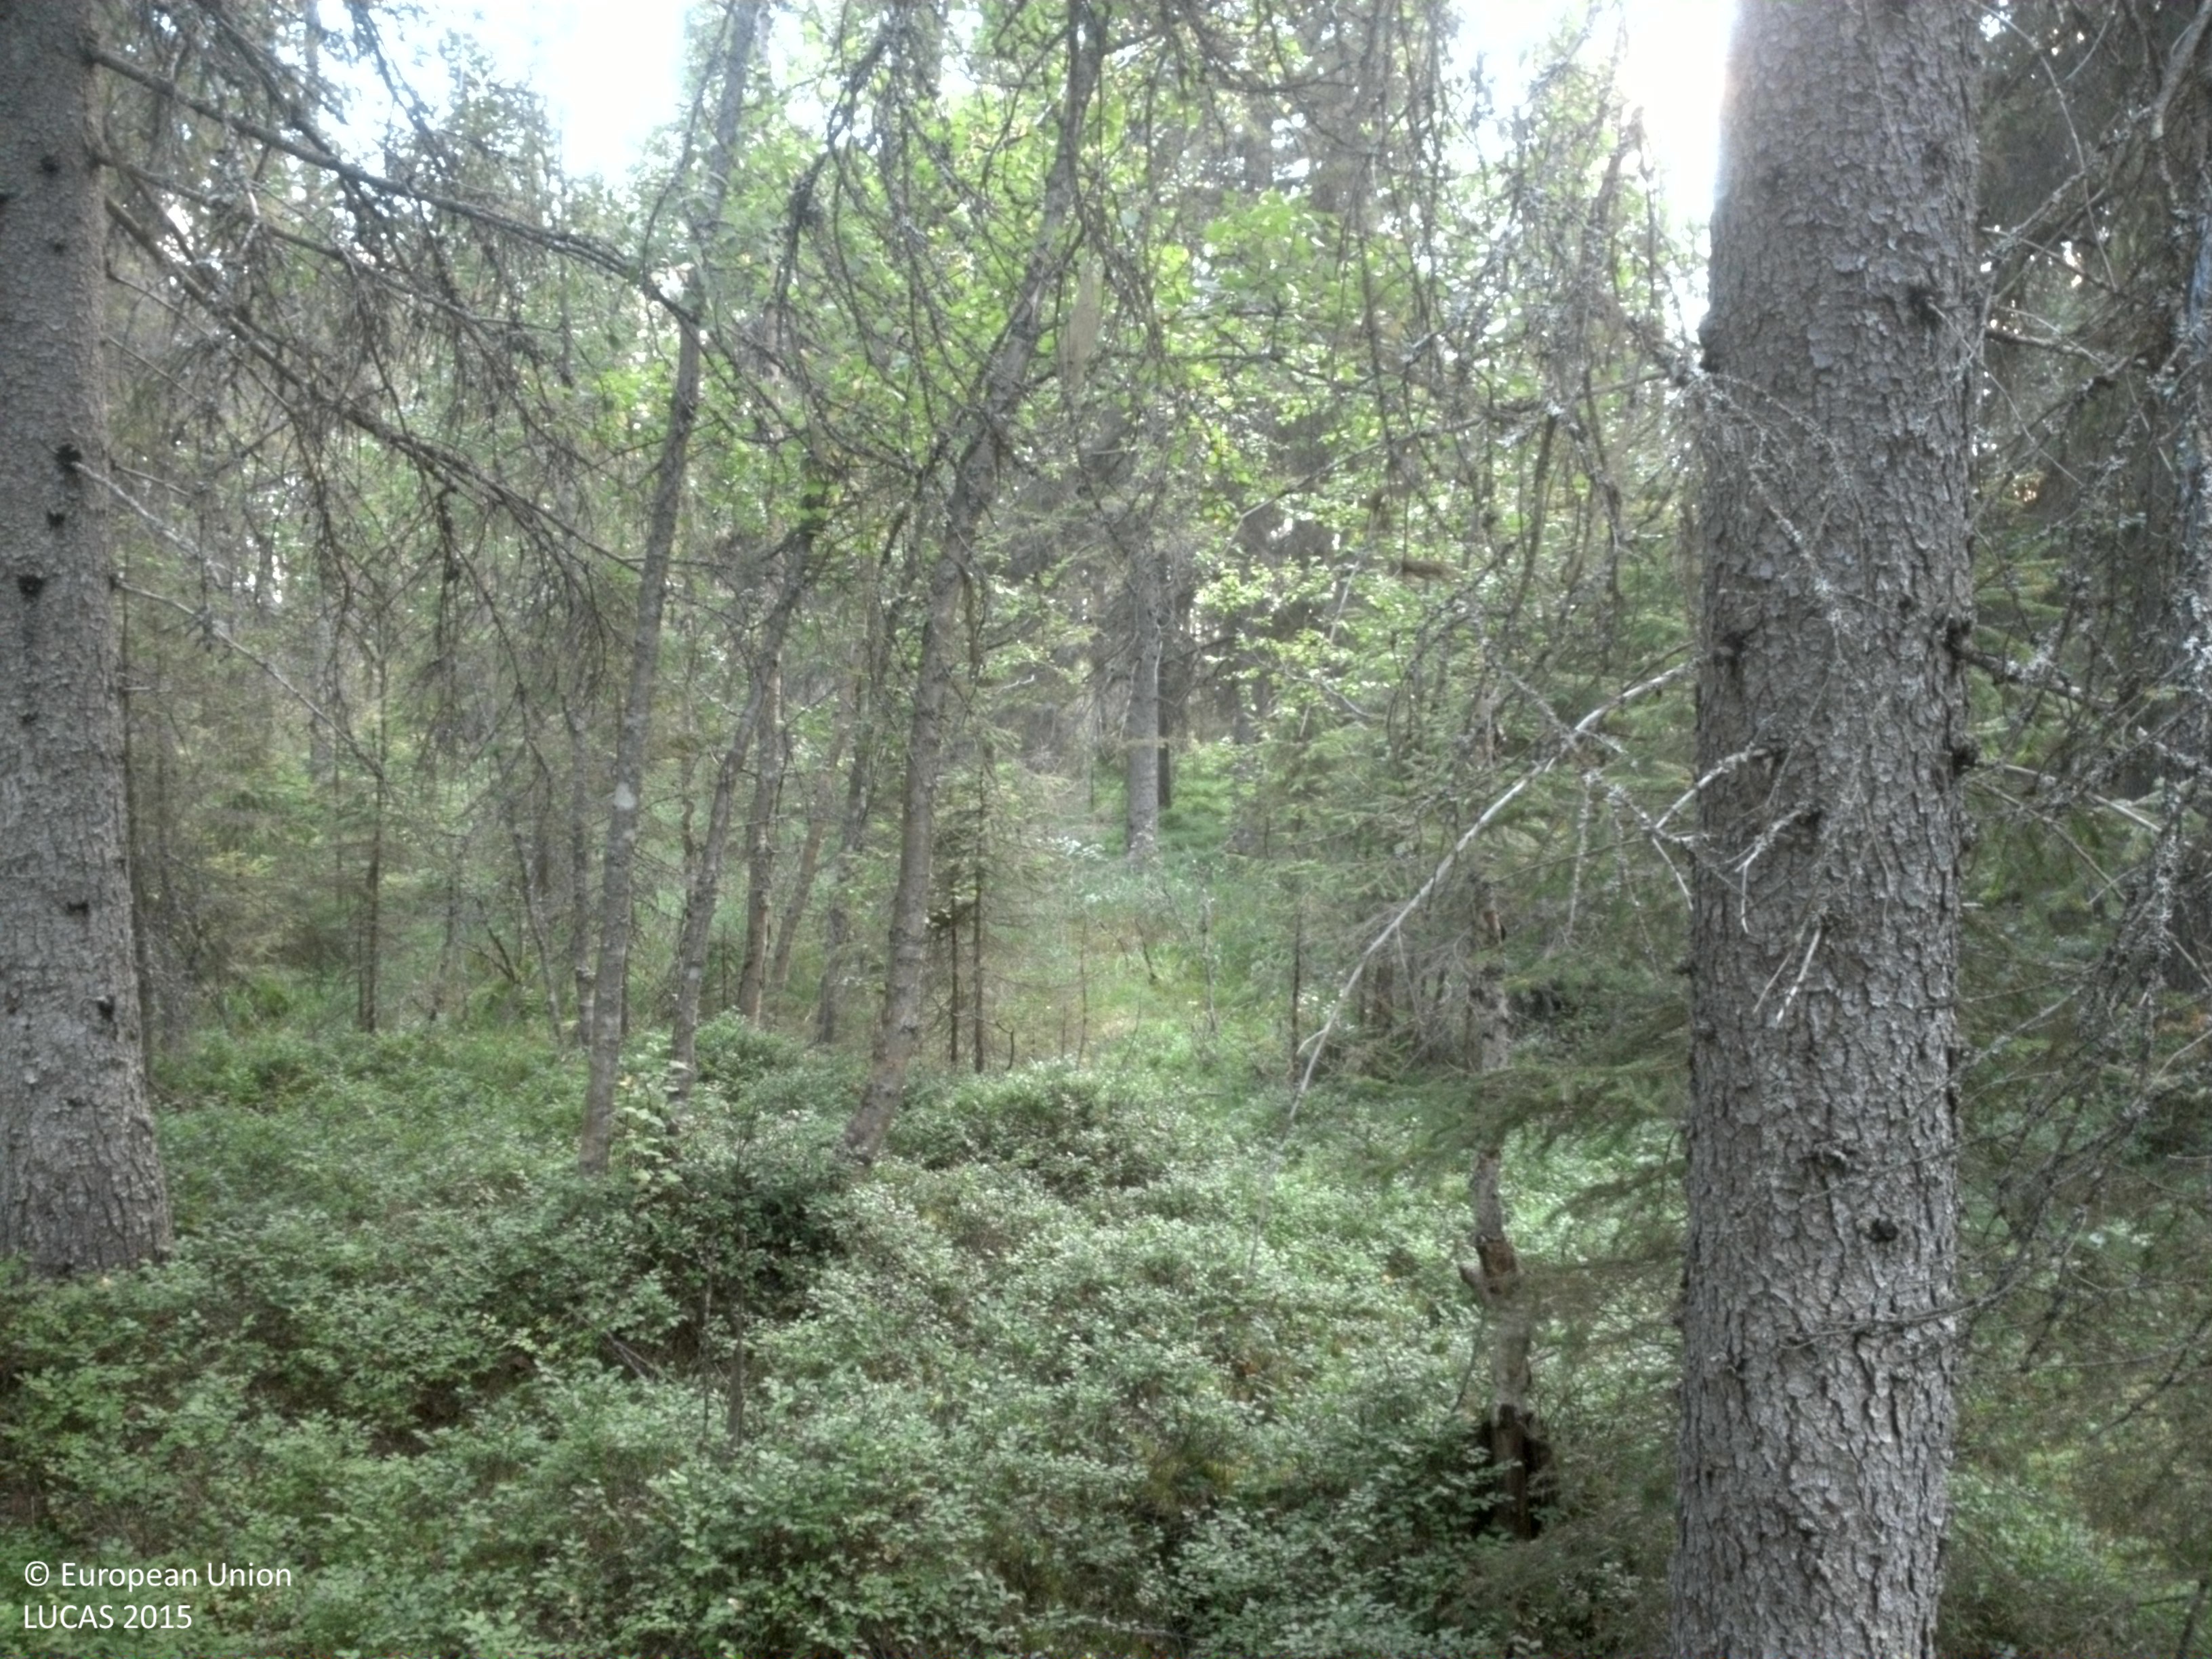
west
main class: Woodland
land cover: Spruce dominated coniferous woodland
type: boreal forest
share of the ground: 50 - 75 %
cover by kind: coniferous forest trees 70 %, shrubs 25 %, lichens and mosses 5 %
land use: Forestry
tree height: > 5 m
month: August
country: SE
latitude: 64.2458
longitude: 20.5618
